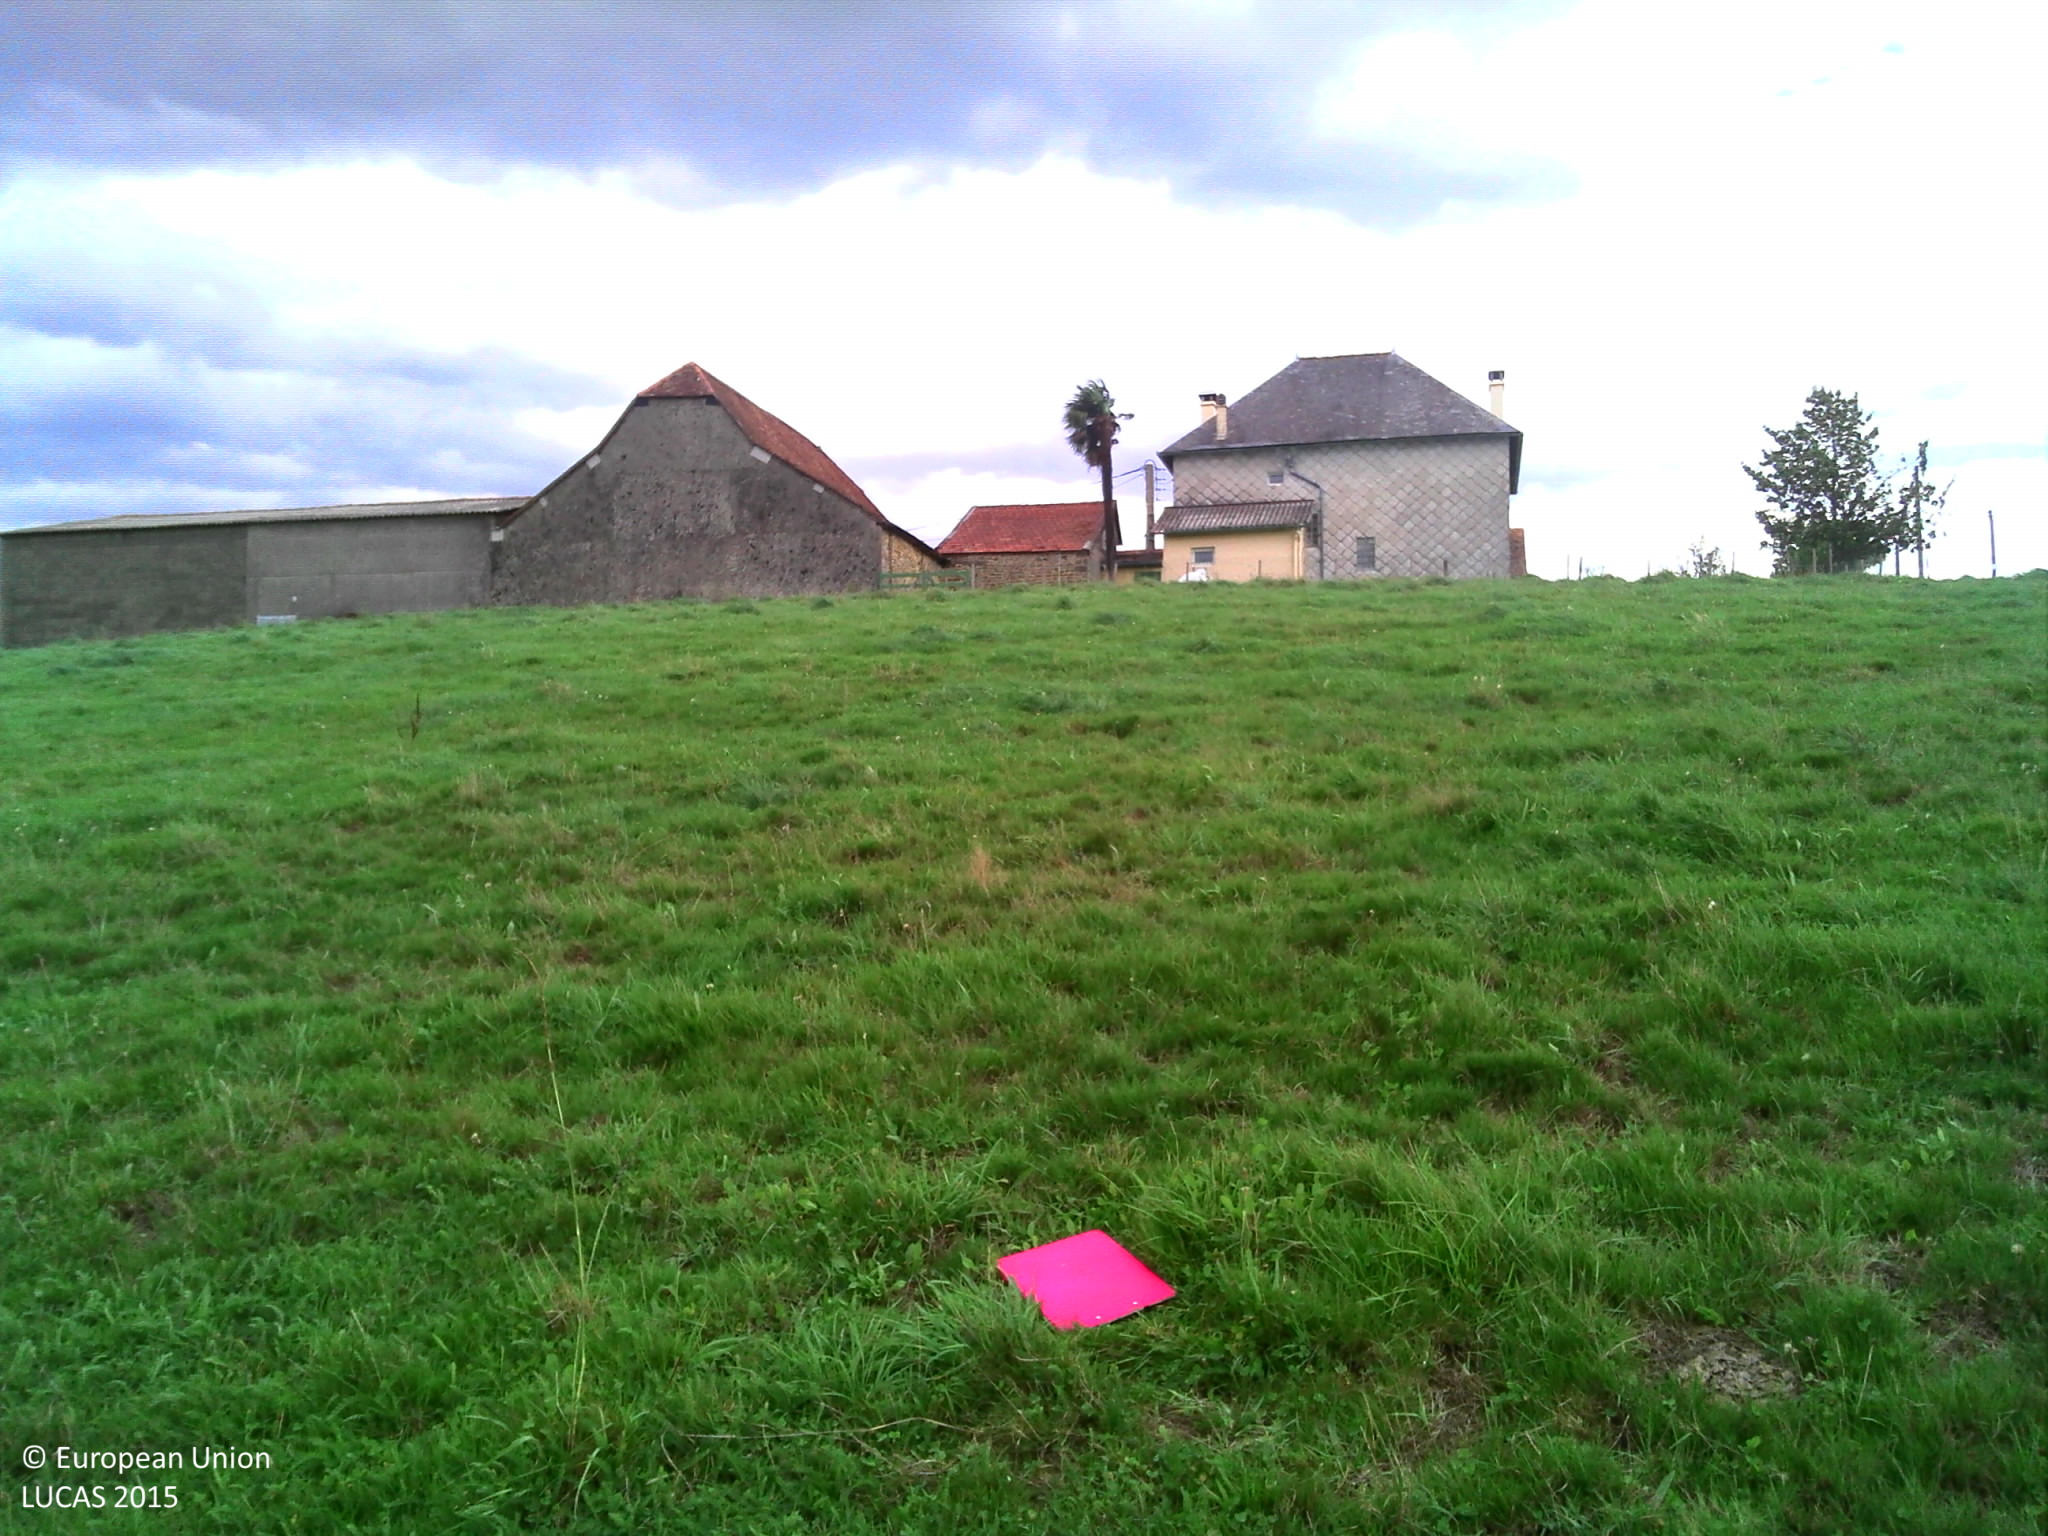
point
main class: Grassland
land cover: Grassland without tree/shrub cover
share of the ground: > 75 %
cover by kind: herbaceous plants 100 %
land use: Agriculture (excluding fallow land and kitchen gardens)
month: September
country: FR
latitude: 43.3789
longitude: -0.6865
